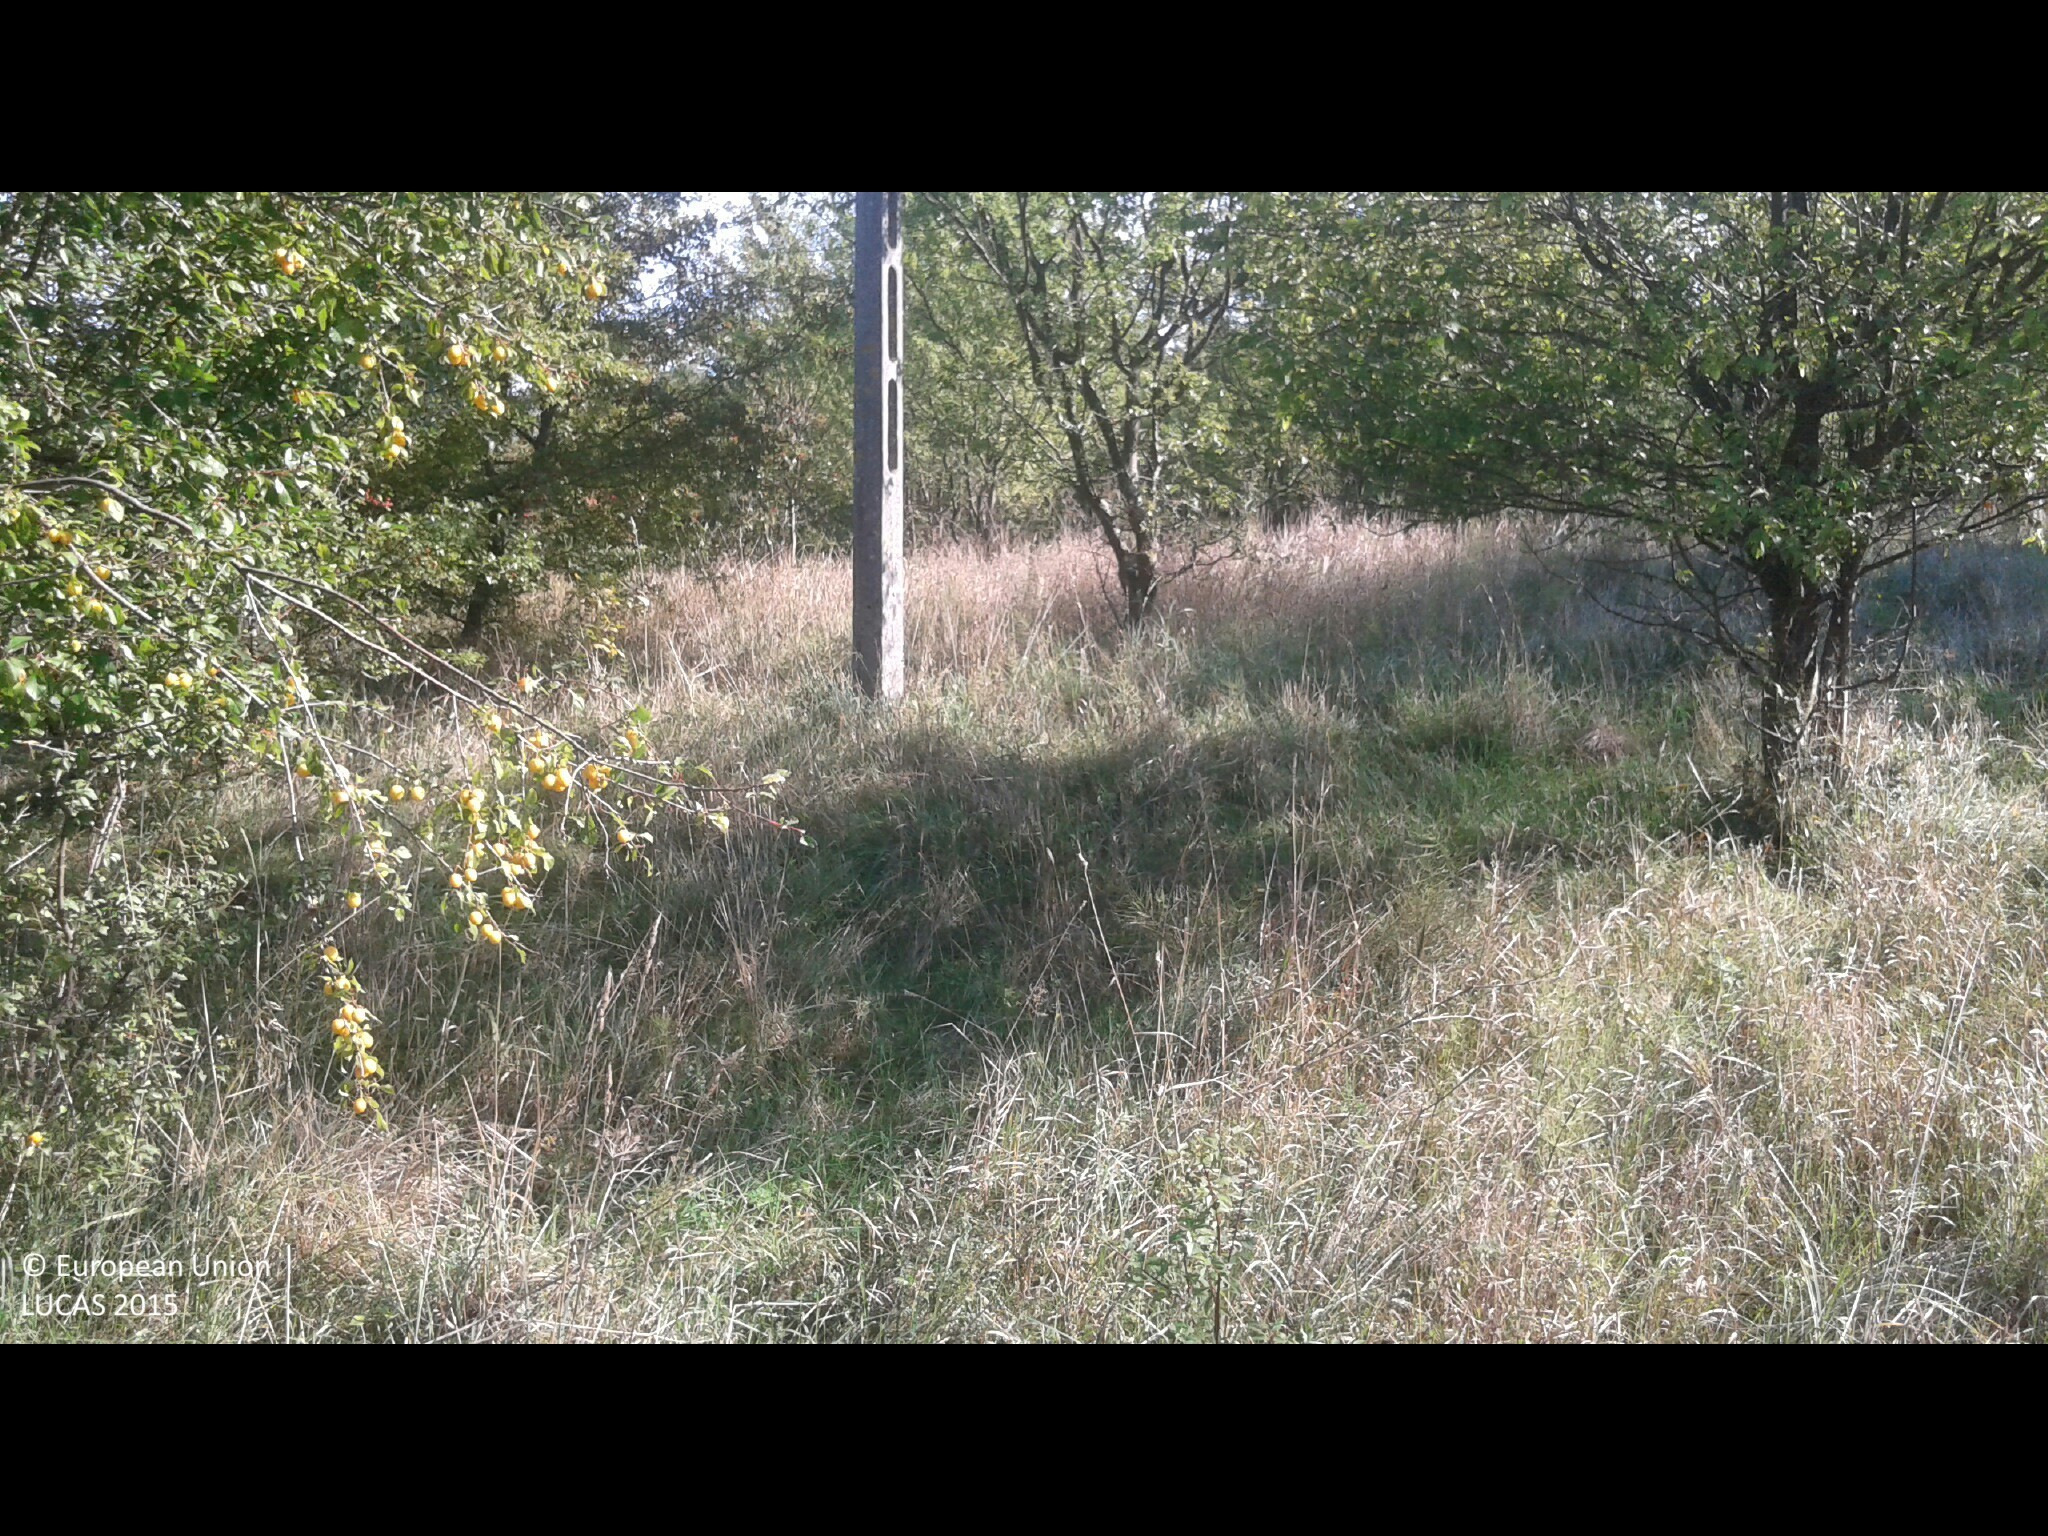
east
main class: Cropland
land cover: Cherry fruit
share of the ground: 25 - 50 %
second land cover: Grassland without tree/shrub cover
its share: > 75 %
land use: Agriculture (excluding fallow land and kitchen gardens)
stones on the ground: < 10 %
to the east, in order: Cherry fruit; Grassland without tree/shrub cover; Fences; Shrubland with sparse tree cover; Electric lines; Shrubland with sparse tree cover; Fences; Apple fruit; Broadleaved woodland
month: September
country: PL
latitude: 53.8554
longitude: 20.2350
